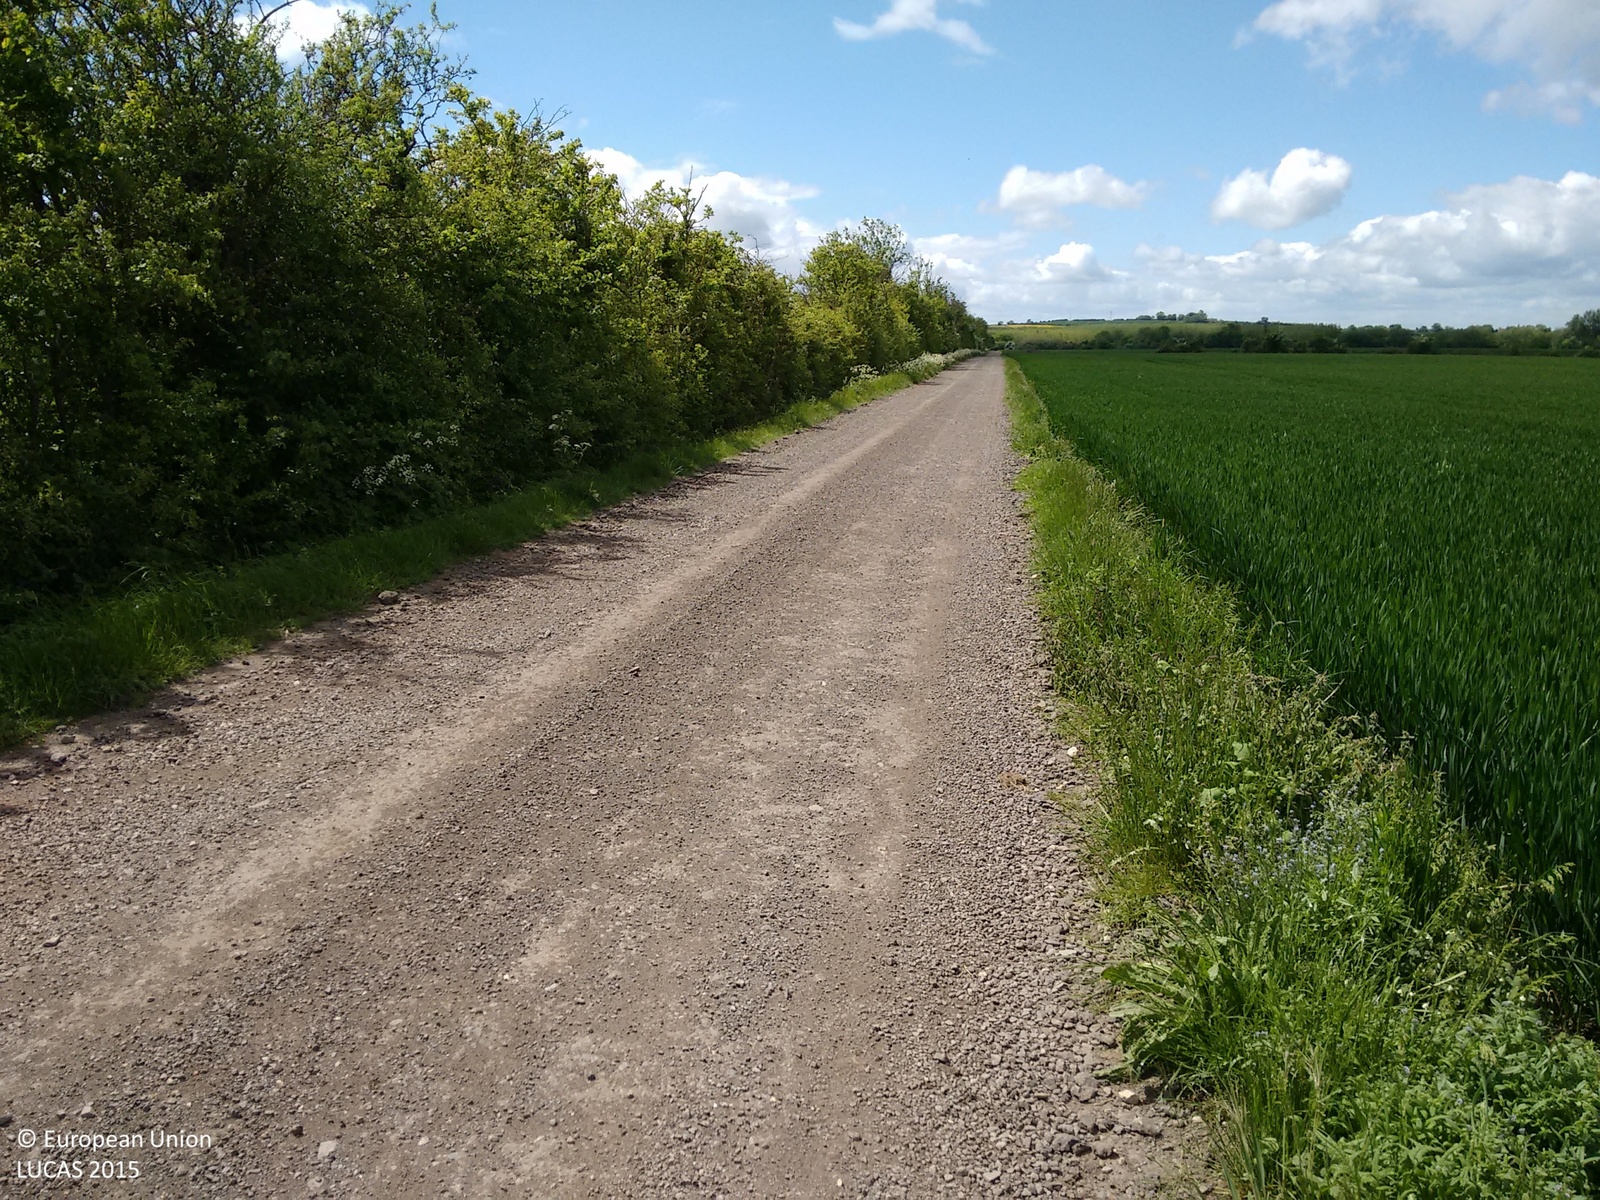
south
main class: Cropland
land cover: Barley
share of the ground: > 75 %
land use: Agriculture (excluding fallow land and kitchen gardens)
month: May
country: GB
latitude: 52.2496
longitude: -1.3421
